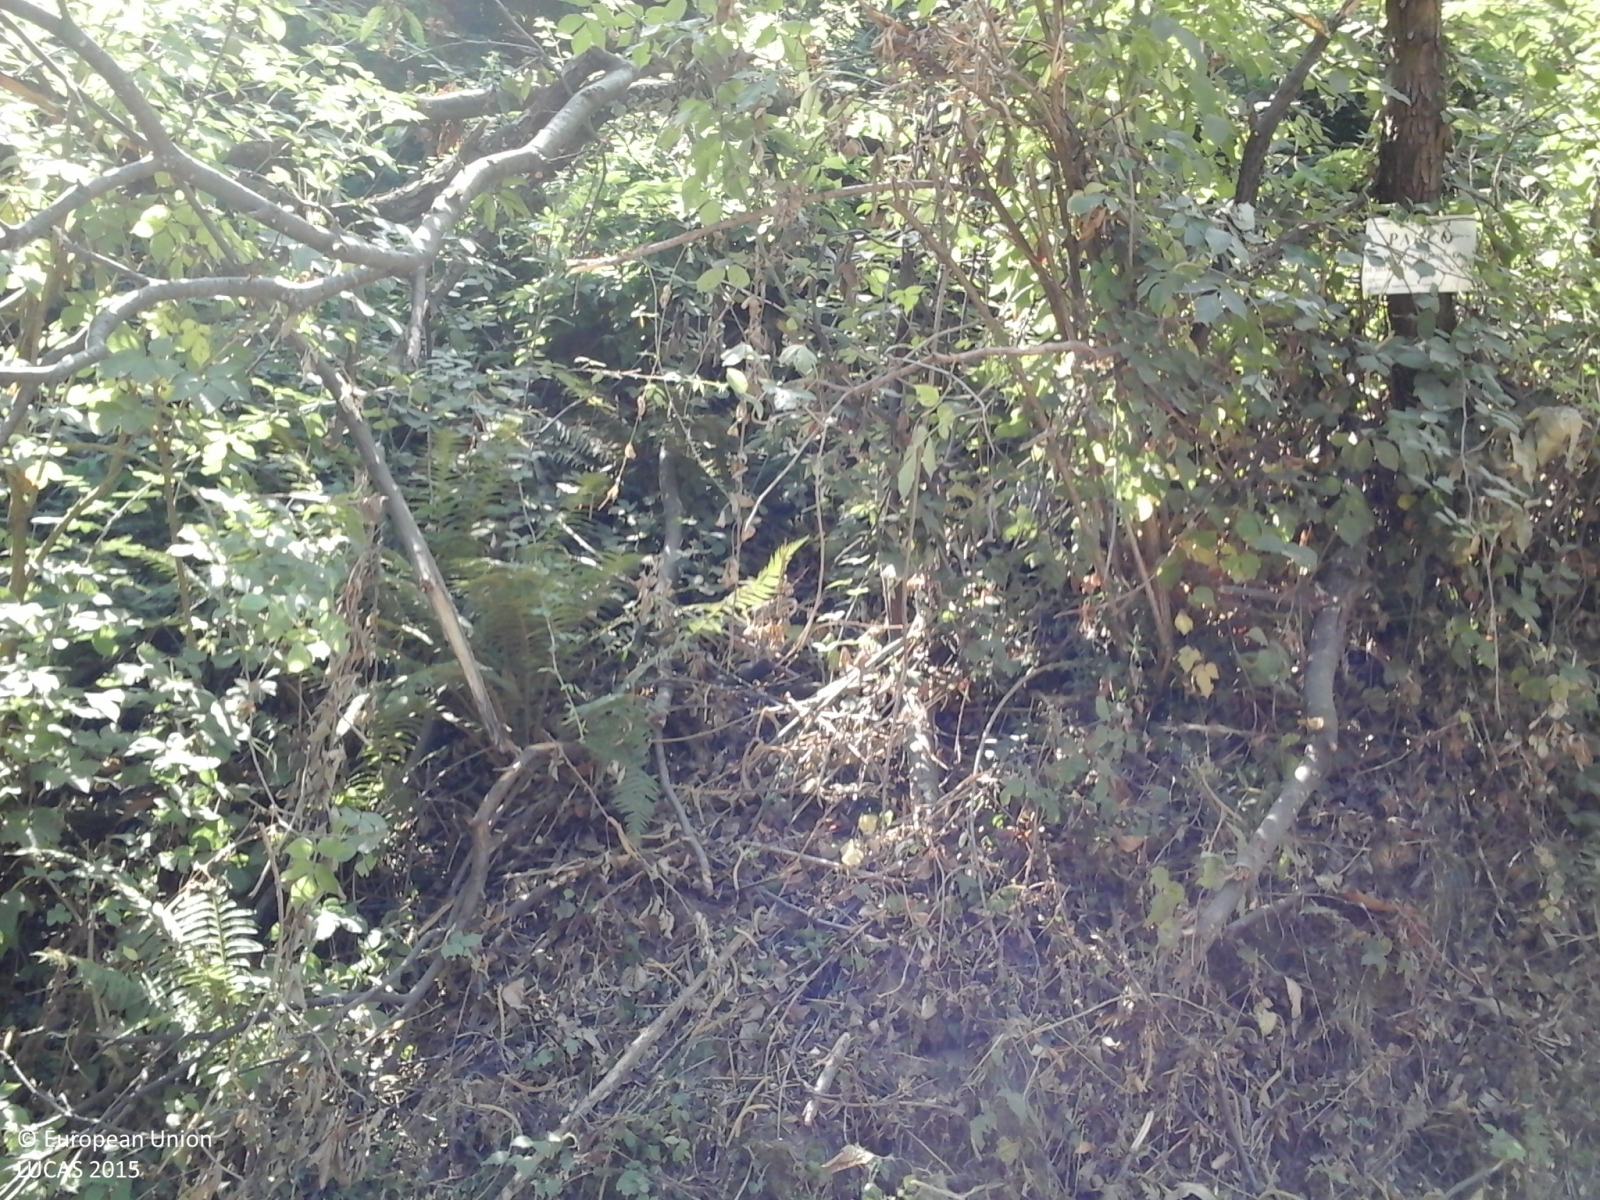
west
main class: Woodland
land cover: Broadleaved woodland
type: thermophilous deciduous forest
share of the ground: > 75 %
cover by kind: broadleaved forest trees 75 %, coniferous forest trees 25 %
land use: Forestry
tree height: > 5 m
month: July
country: IT
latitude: 44.0980
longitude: 9.9128
